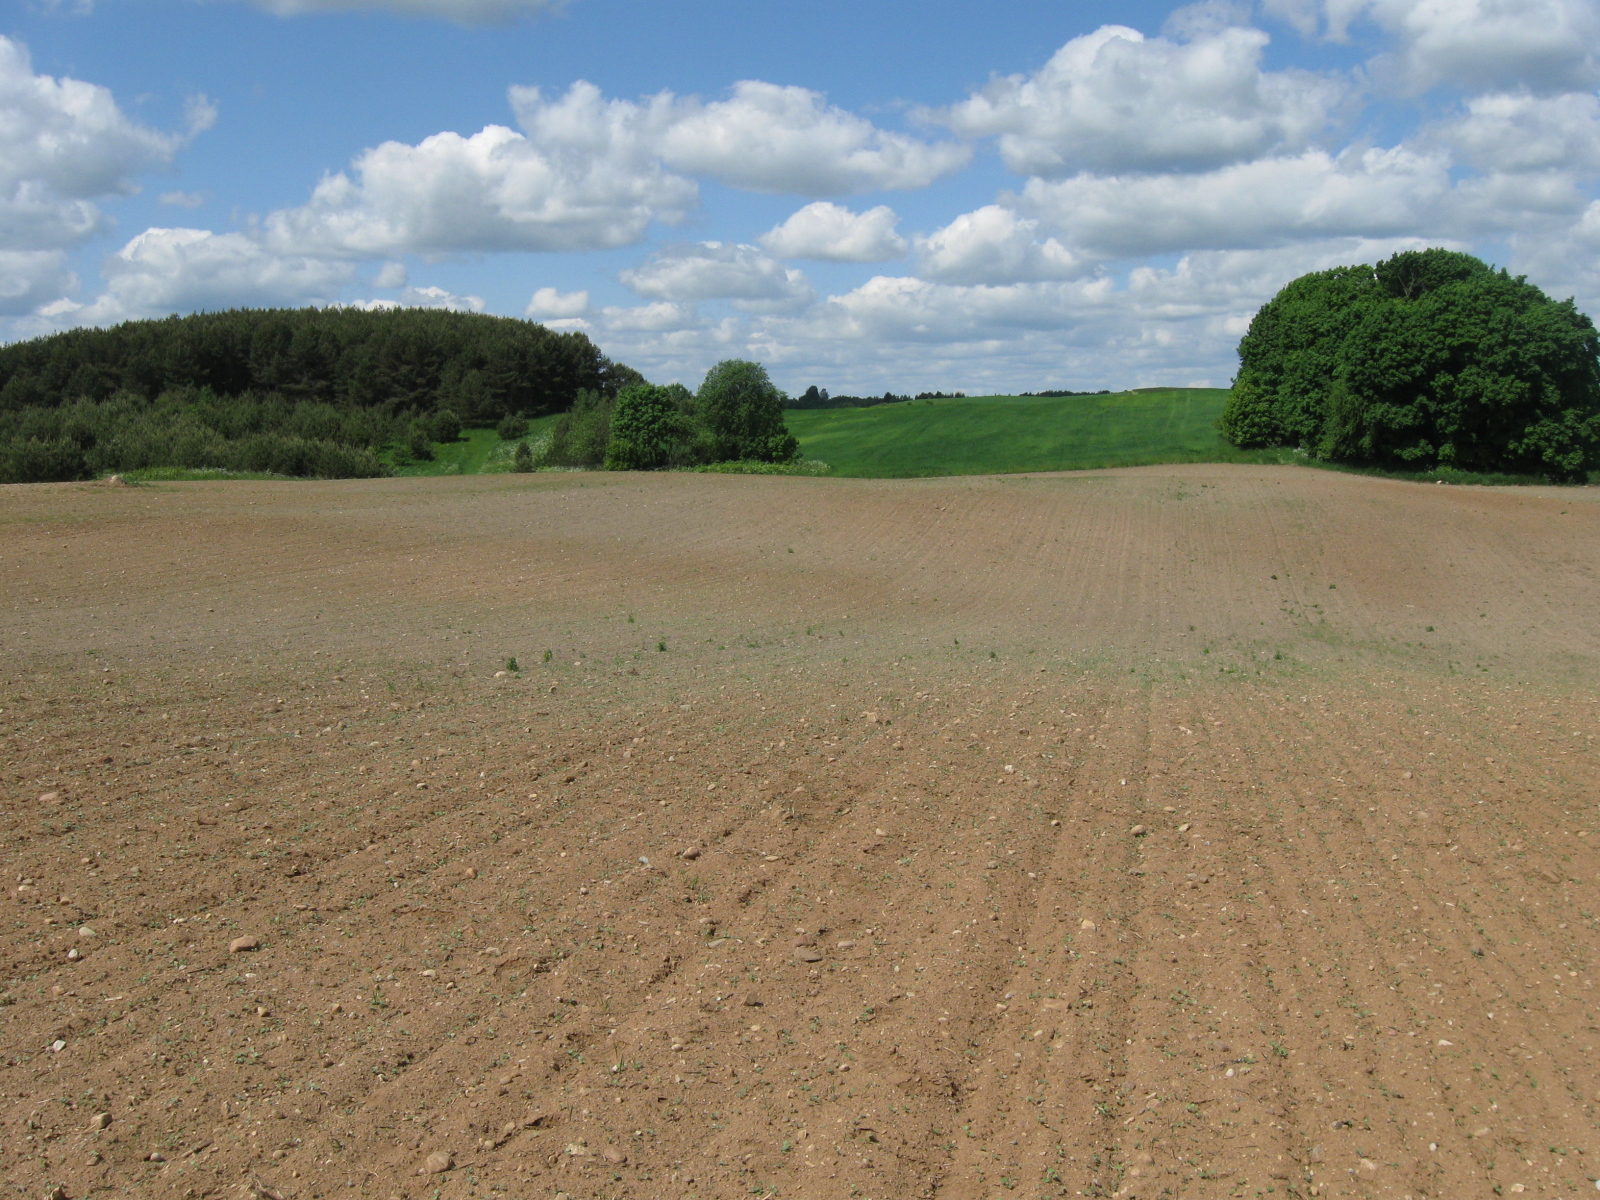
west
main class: Cropland
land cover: Rape and turnip rape
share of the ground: < 10 %
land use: Agriculture (excluding fallow land and kitchen gardens)
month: May
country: LT
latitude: 54.2997
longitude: 23.1837
